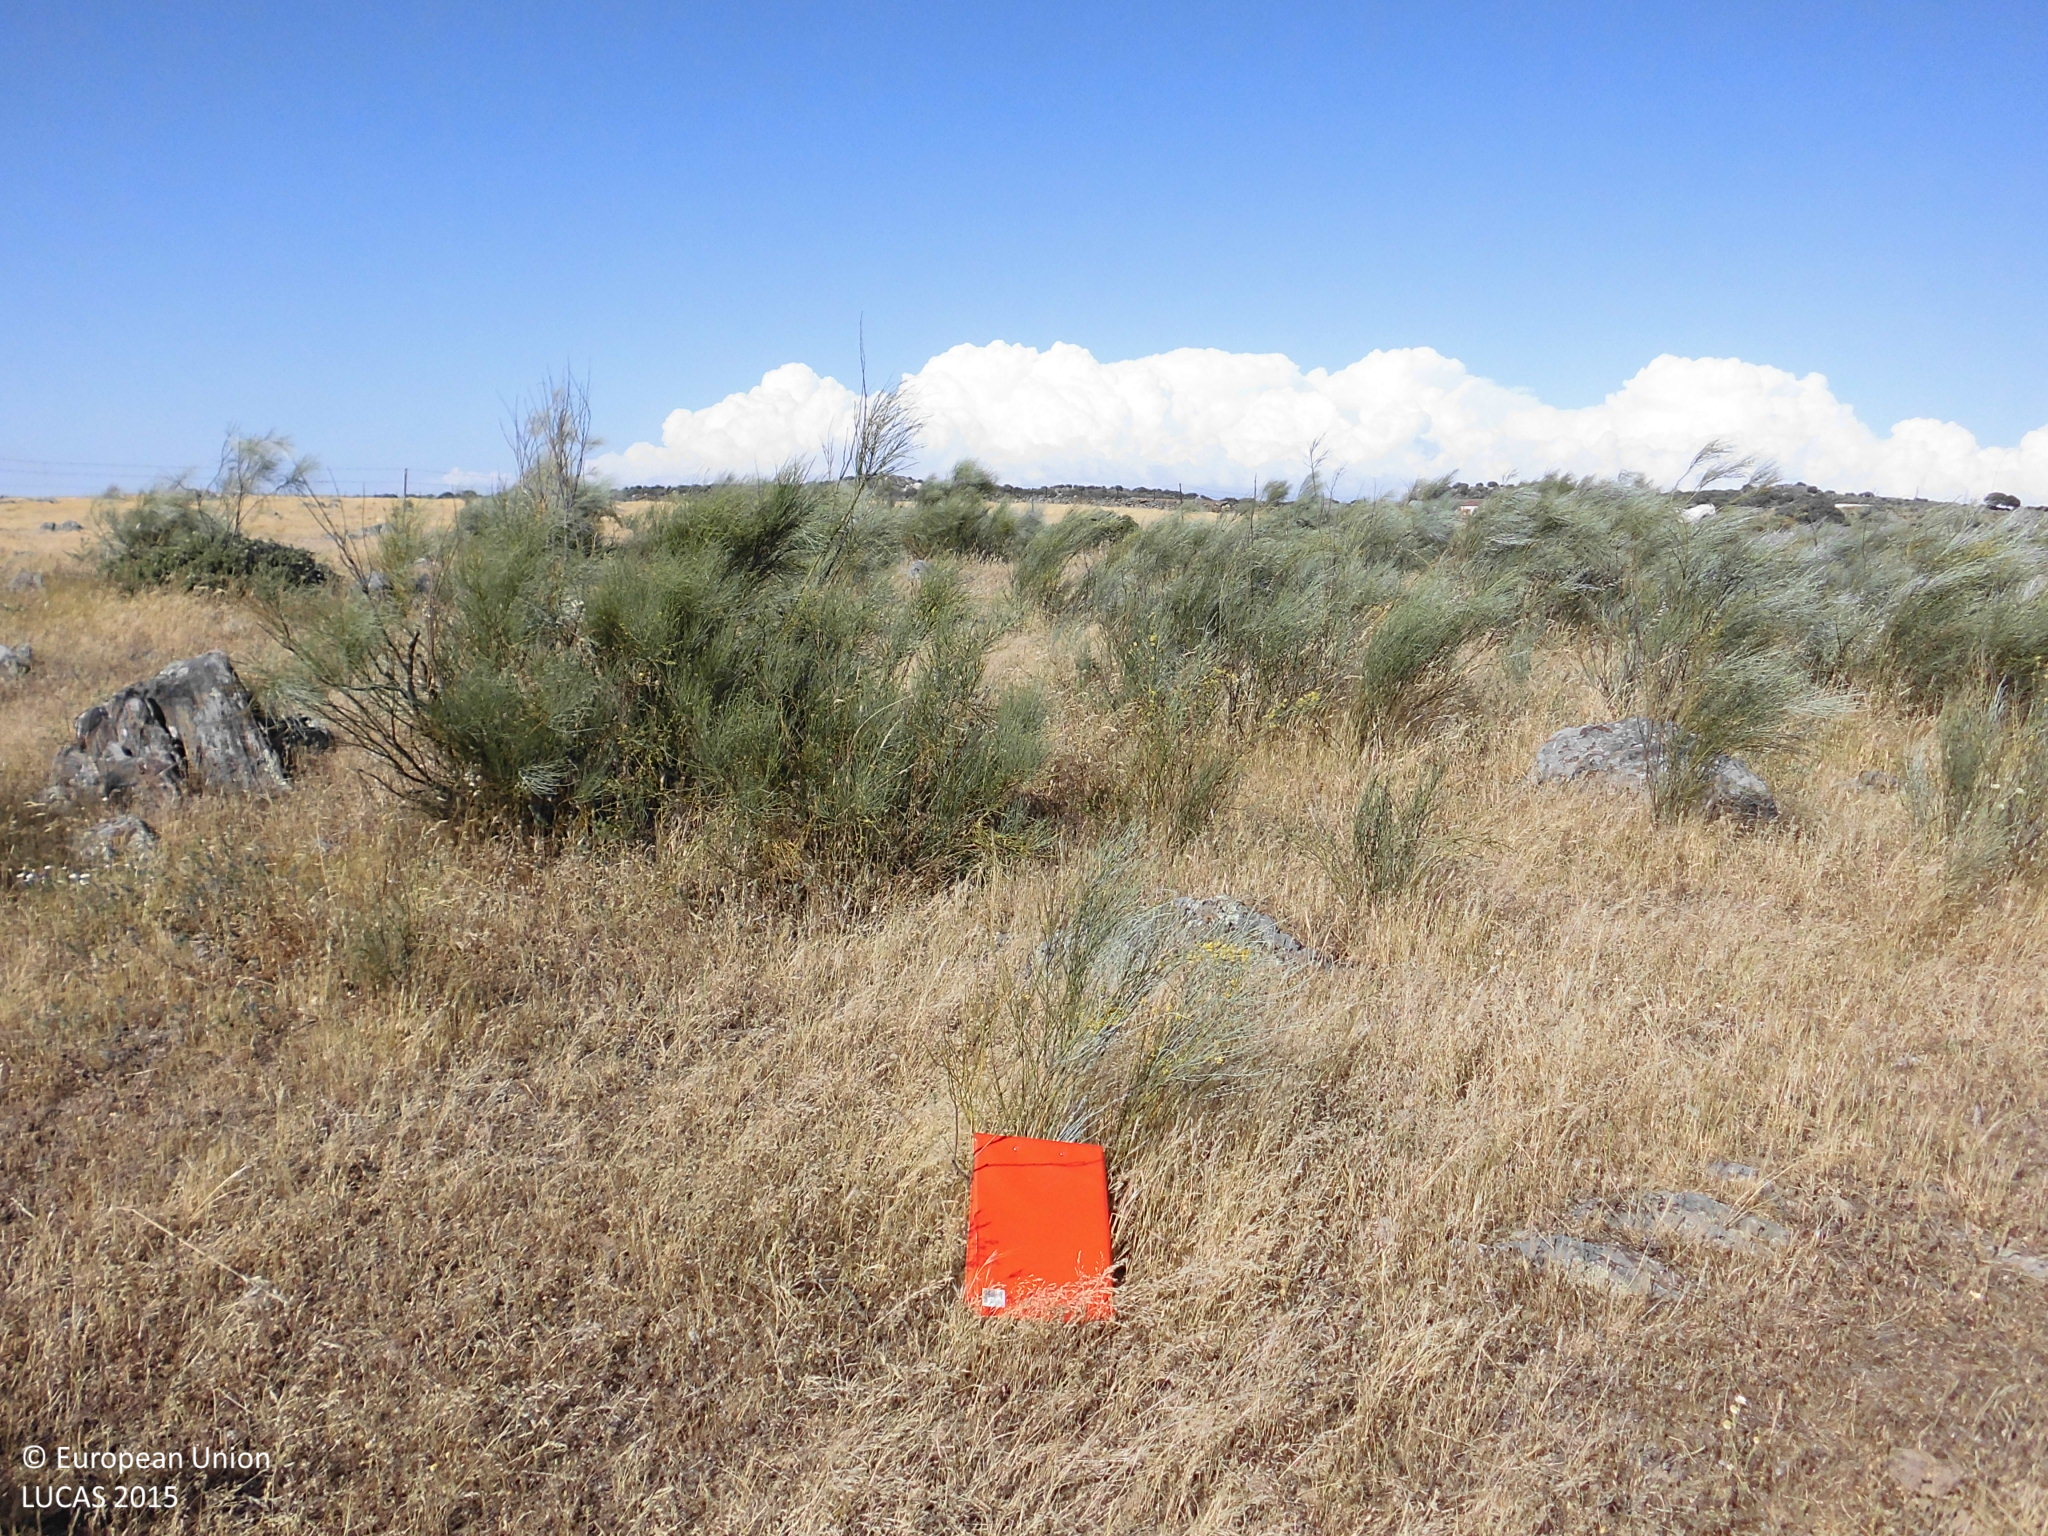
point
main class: Shrubland
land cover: Shrubland without tree cover
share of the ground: 10 - 25 %
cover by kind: herbaceous plants 85 %, shrubs 15 %
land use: Agriculture (excluding fallow land and kitchen gardens)
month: May
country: ES
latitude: 39.4103
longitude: -6.0768
